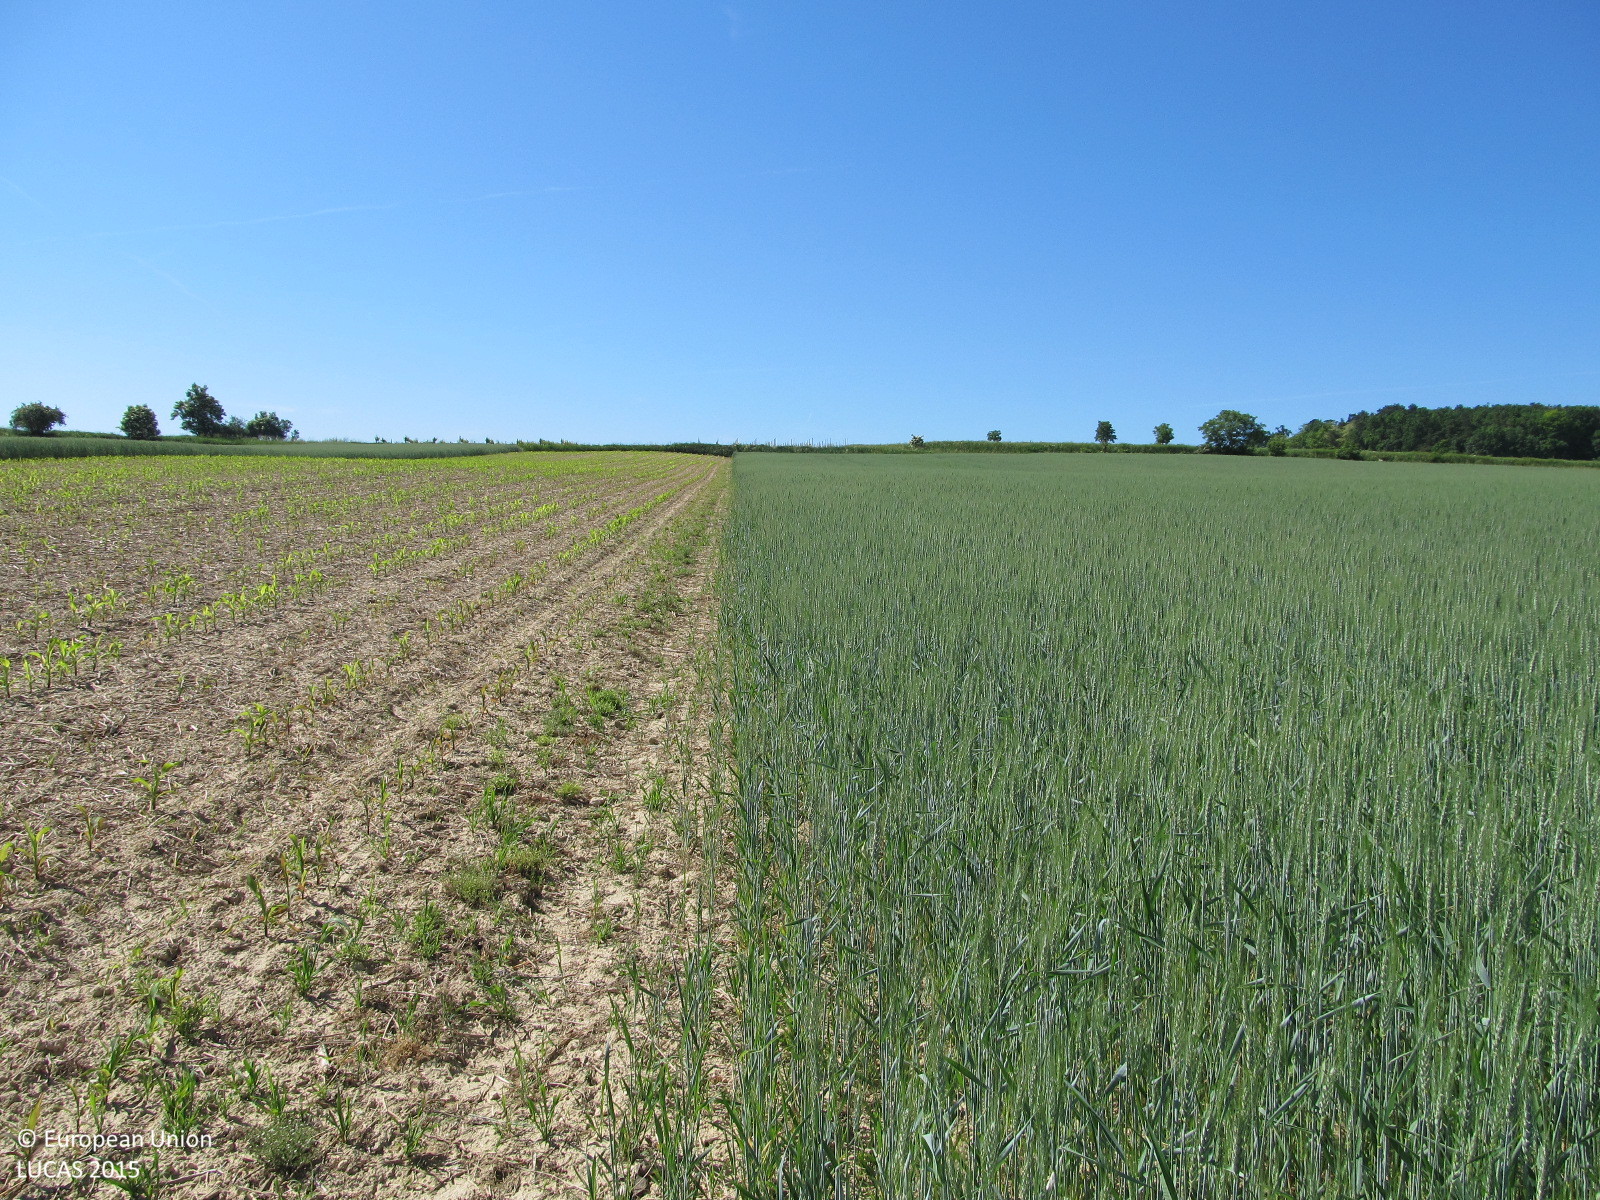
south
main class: Cropland
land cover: Common wheat
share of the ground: > 75 %
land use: Agriculture (excluding fallow land and kitchen gardens)
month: June
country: AT
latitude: 48.5169
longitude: 15.8930
